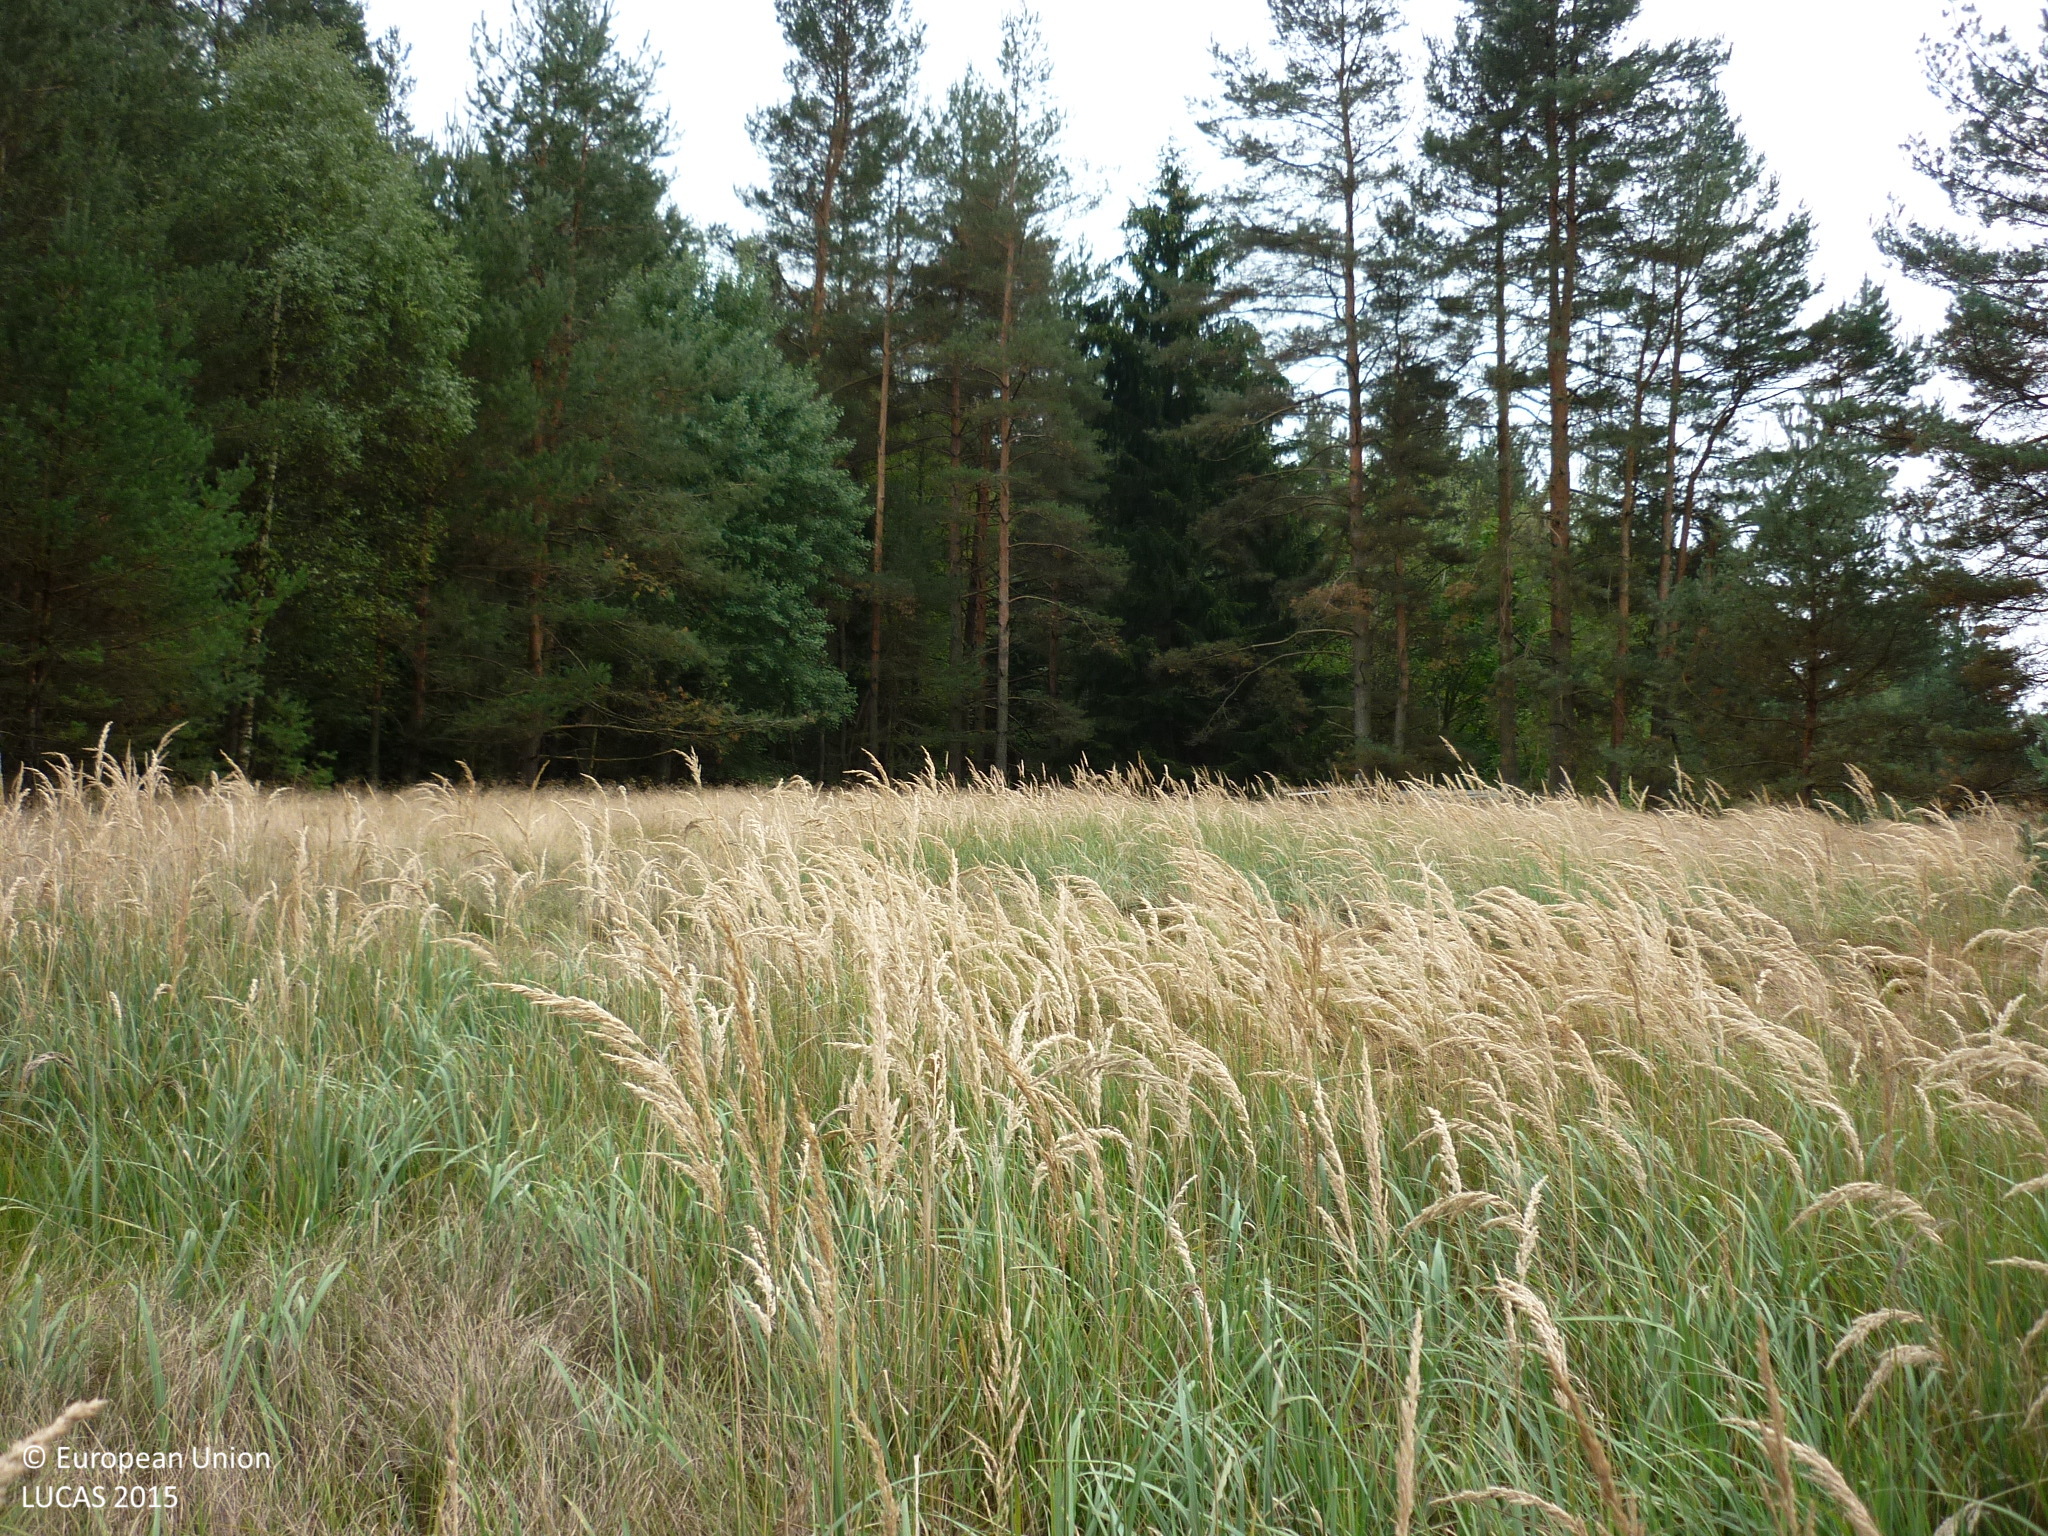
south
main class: Grassland
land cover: Grassland with sparse tree/shrub cover
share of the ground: > 75 %
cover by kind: herbaceous plants 95 %, coniferous forest trees 5 %
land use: Semi-natural and natural areas not in use
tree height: > 5 m
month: September
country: AT
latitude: 48.8491
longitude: 15.0033
